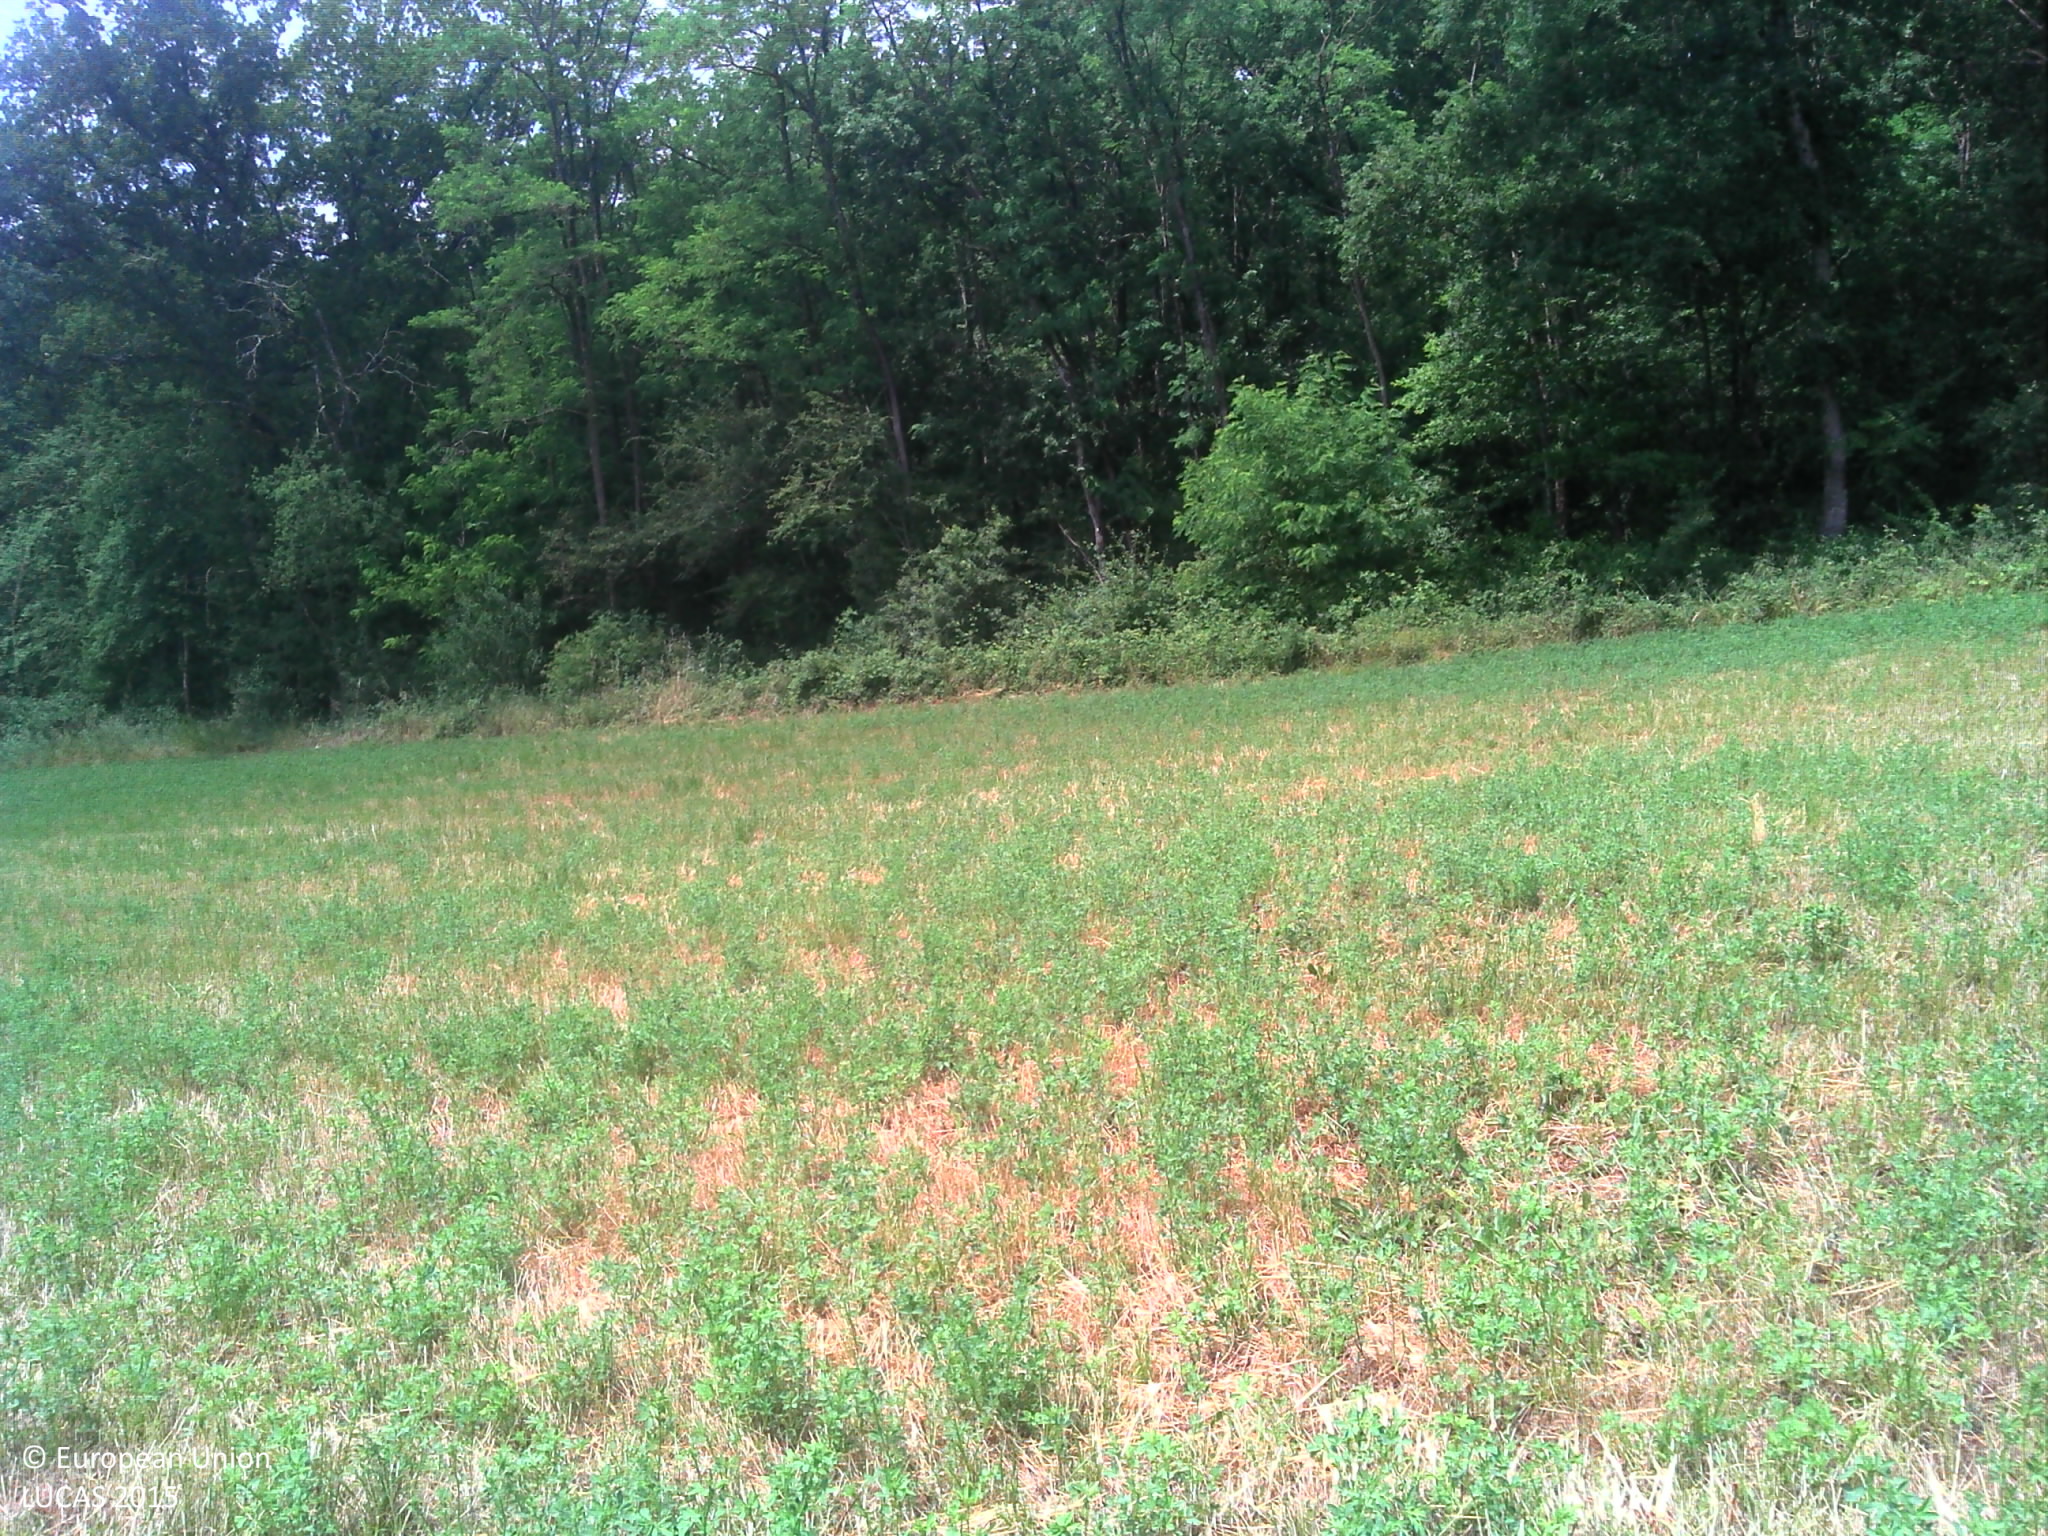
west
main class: Cropland
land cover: Lucerne
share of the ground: > 75 %
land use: Agriculture (excluding fallow land and kitchen gardens)
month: June
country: FR
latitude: 43.7605
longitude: 2.1172
